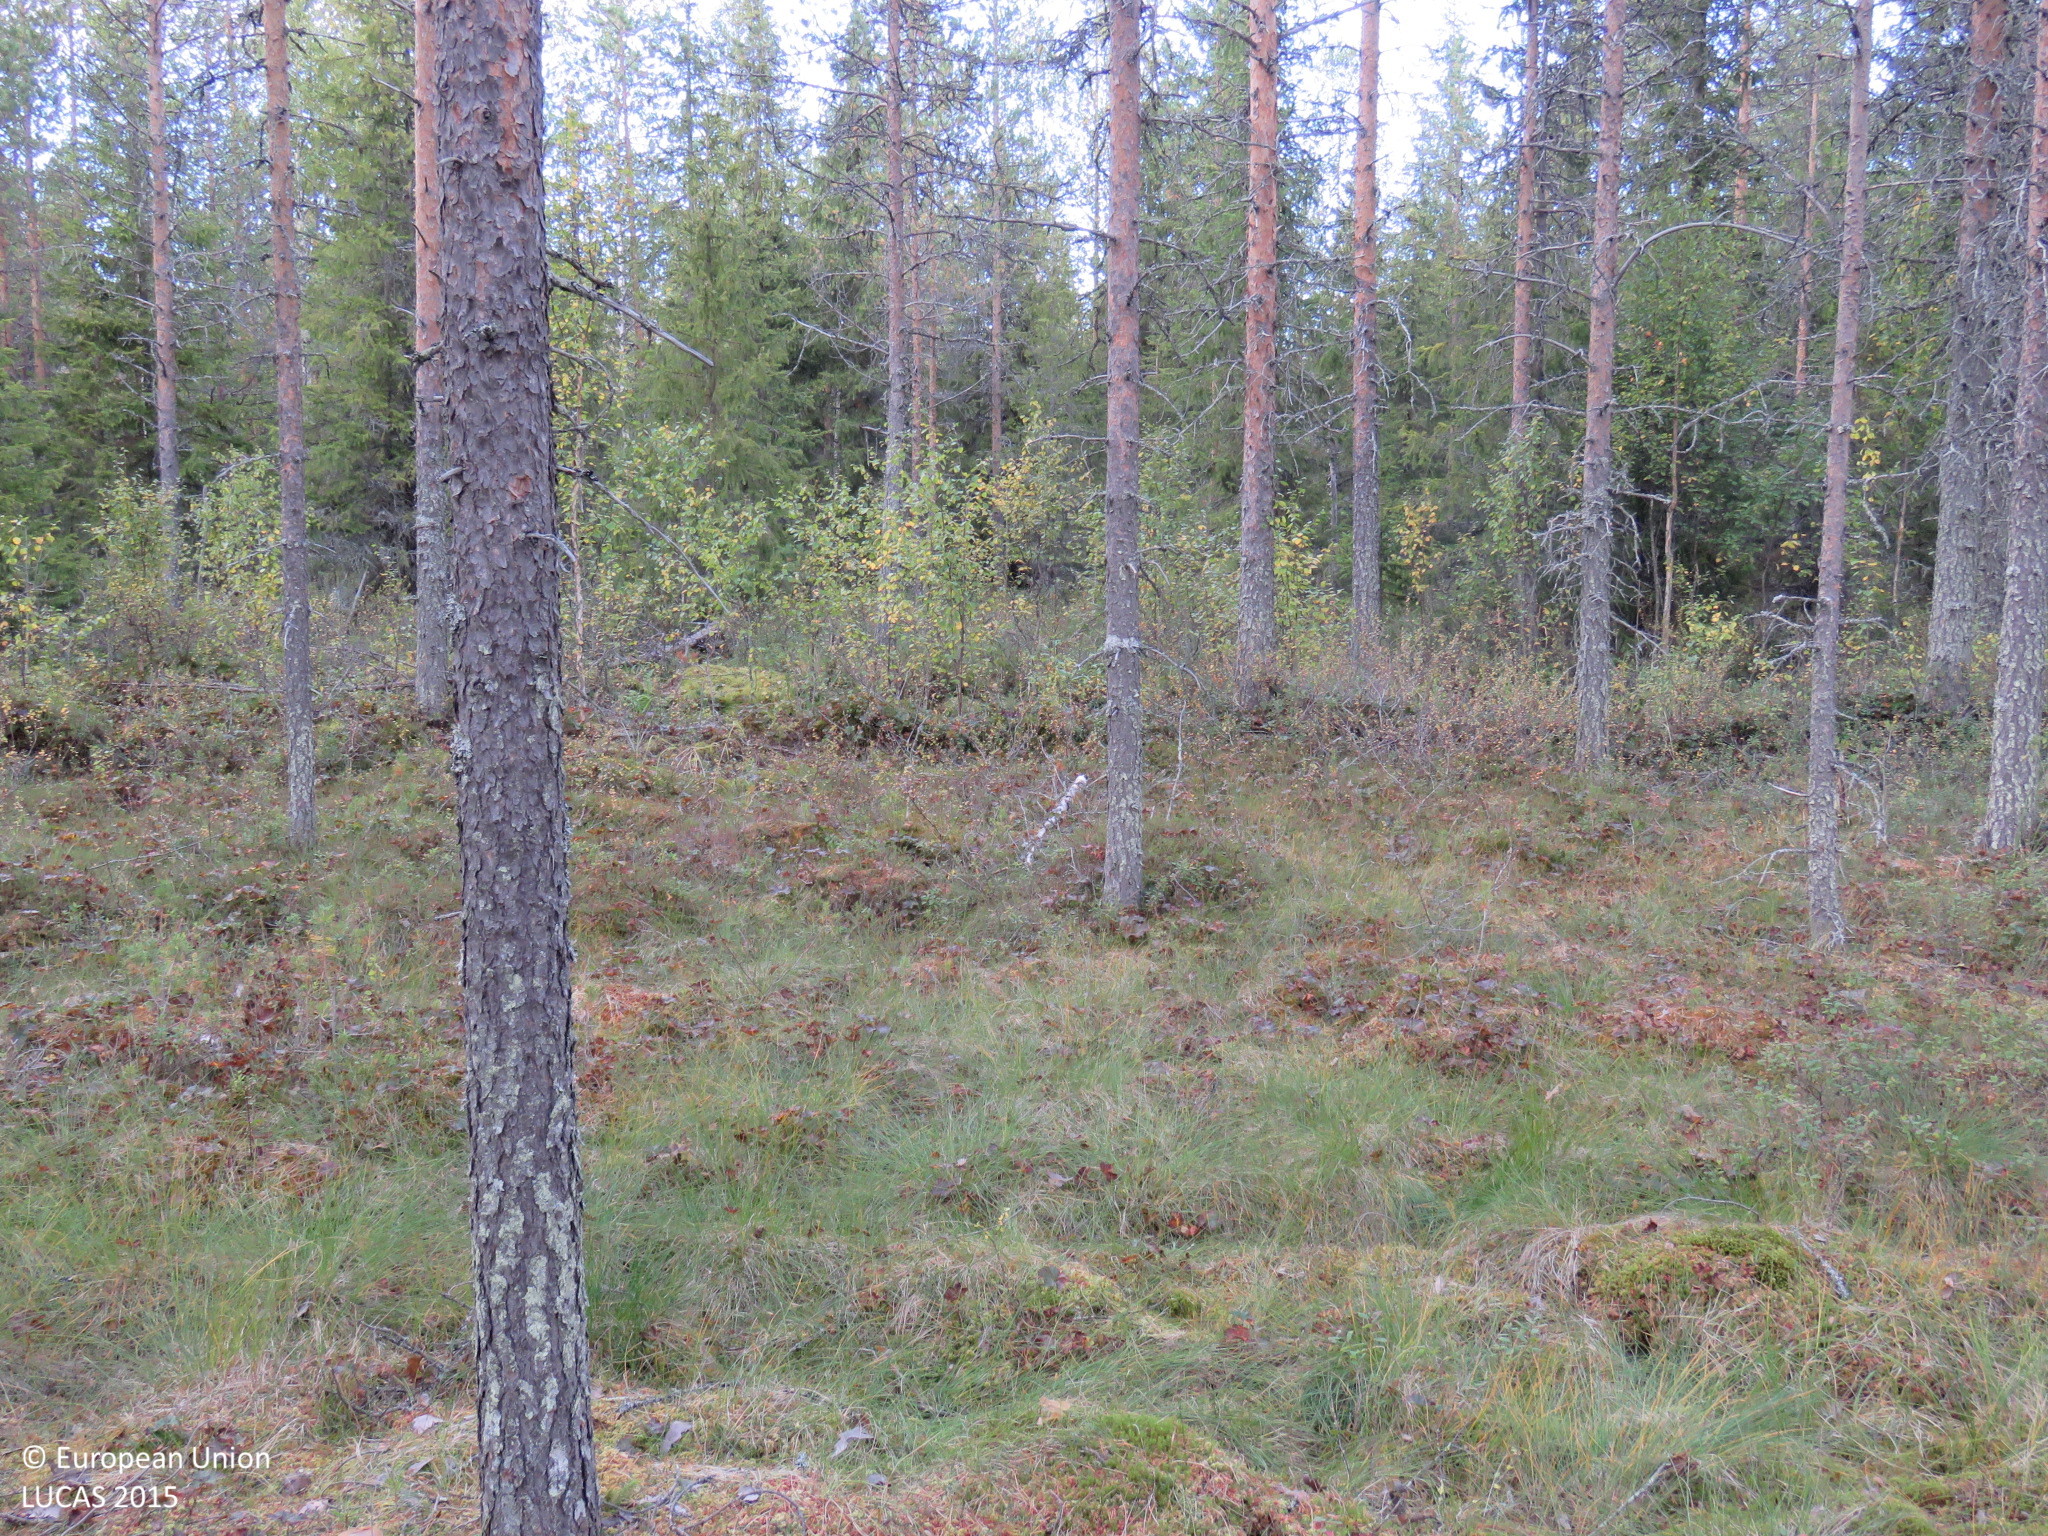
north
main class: Woodland
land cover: Pine dominated coniferous woodland
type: mire and swamp forests
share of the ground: > 75 %
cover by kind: coniferous forest trees 65 %, herbaceous plants 15 %, broadleaved forest trees 10 %, shrubs 5 %, lichens and mosses 5 %
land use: Forestry
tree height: > 5 m
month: September
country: FI
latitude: 65.3740
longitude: 27.6206
